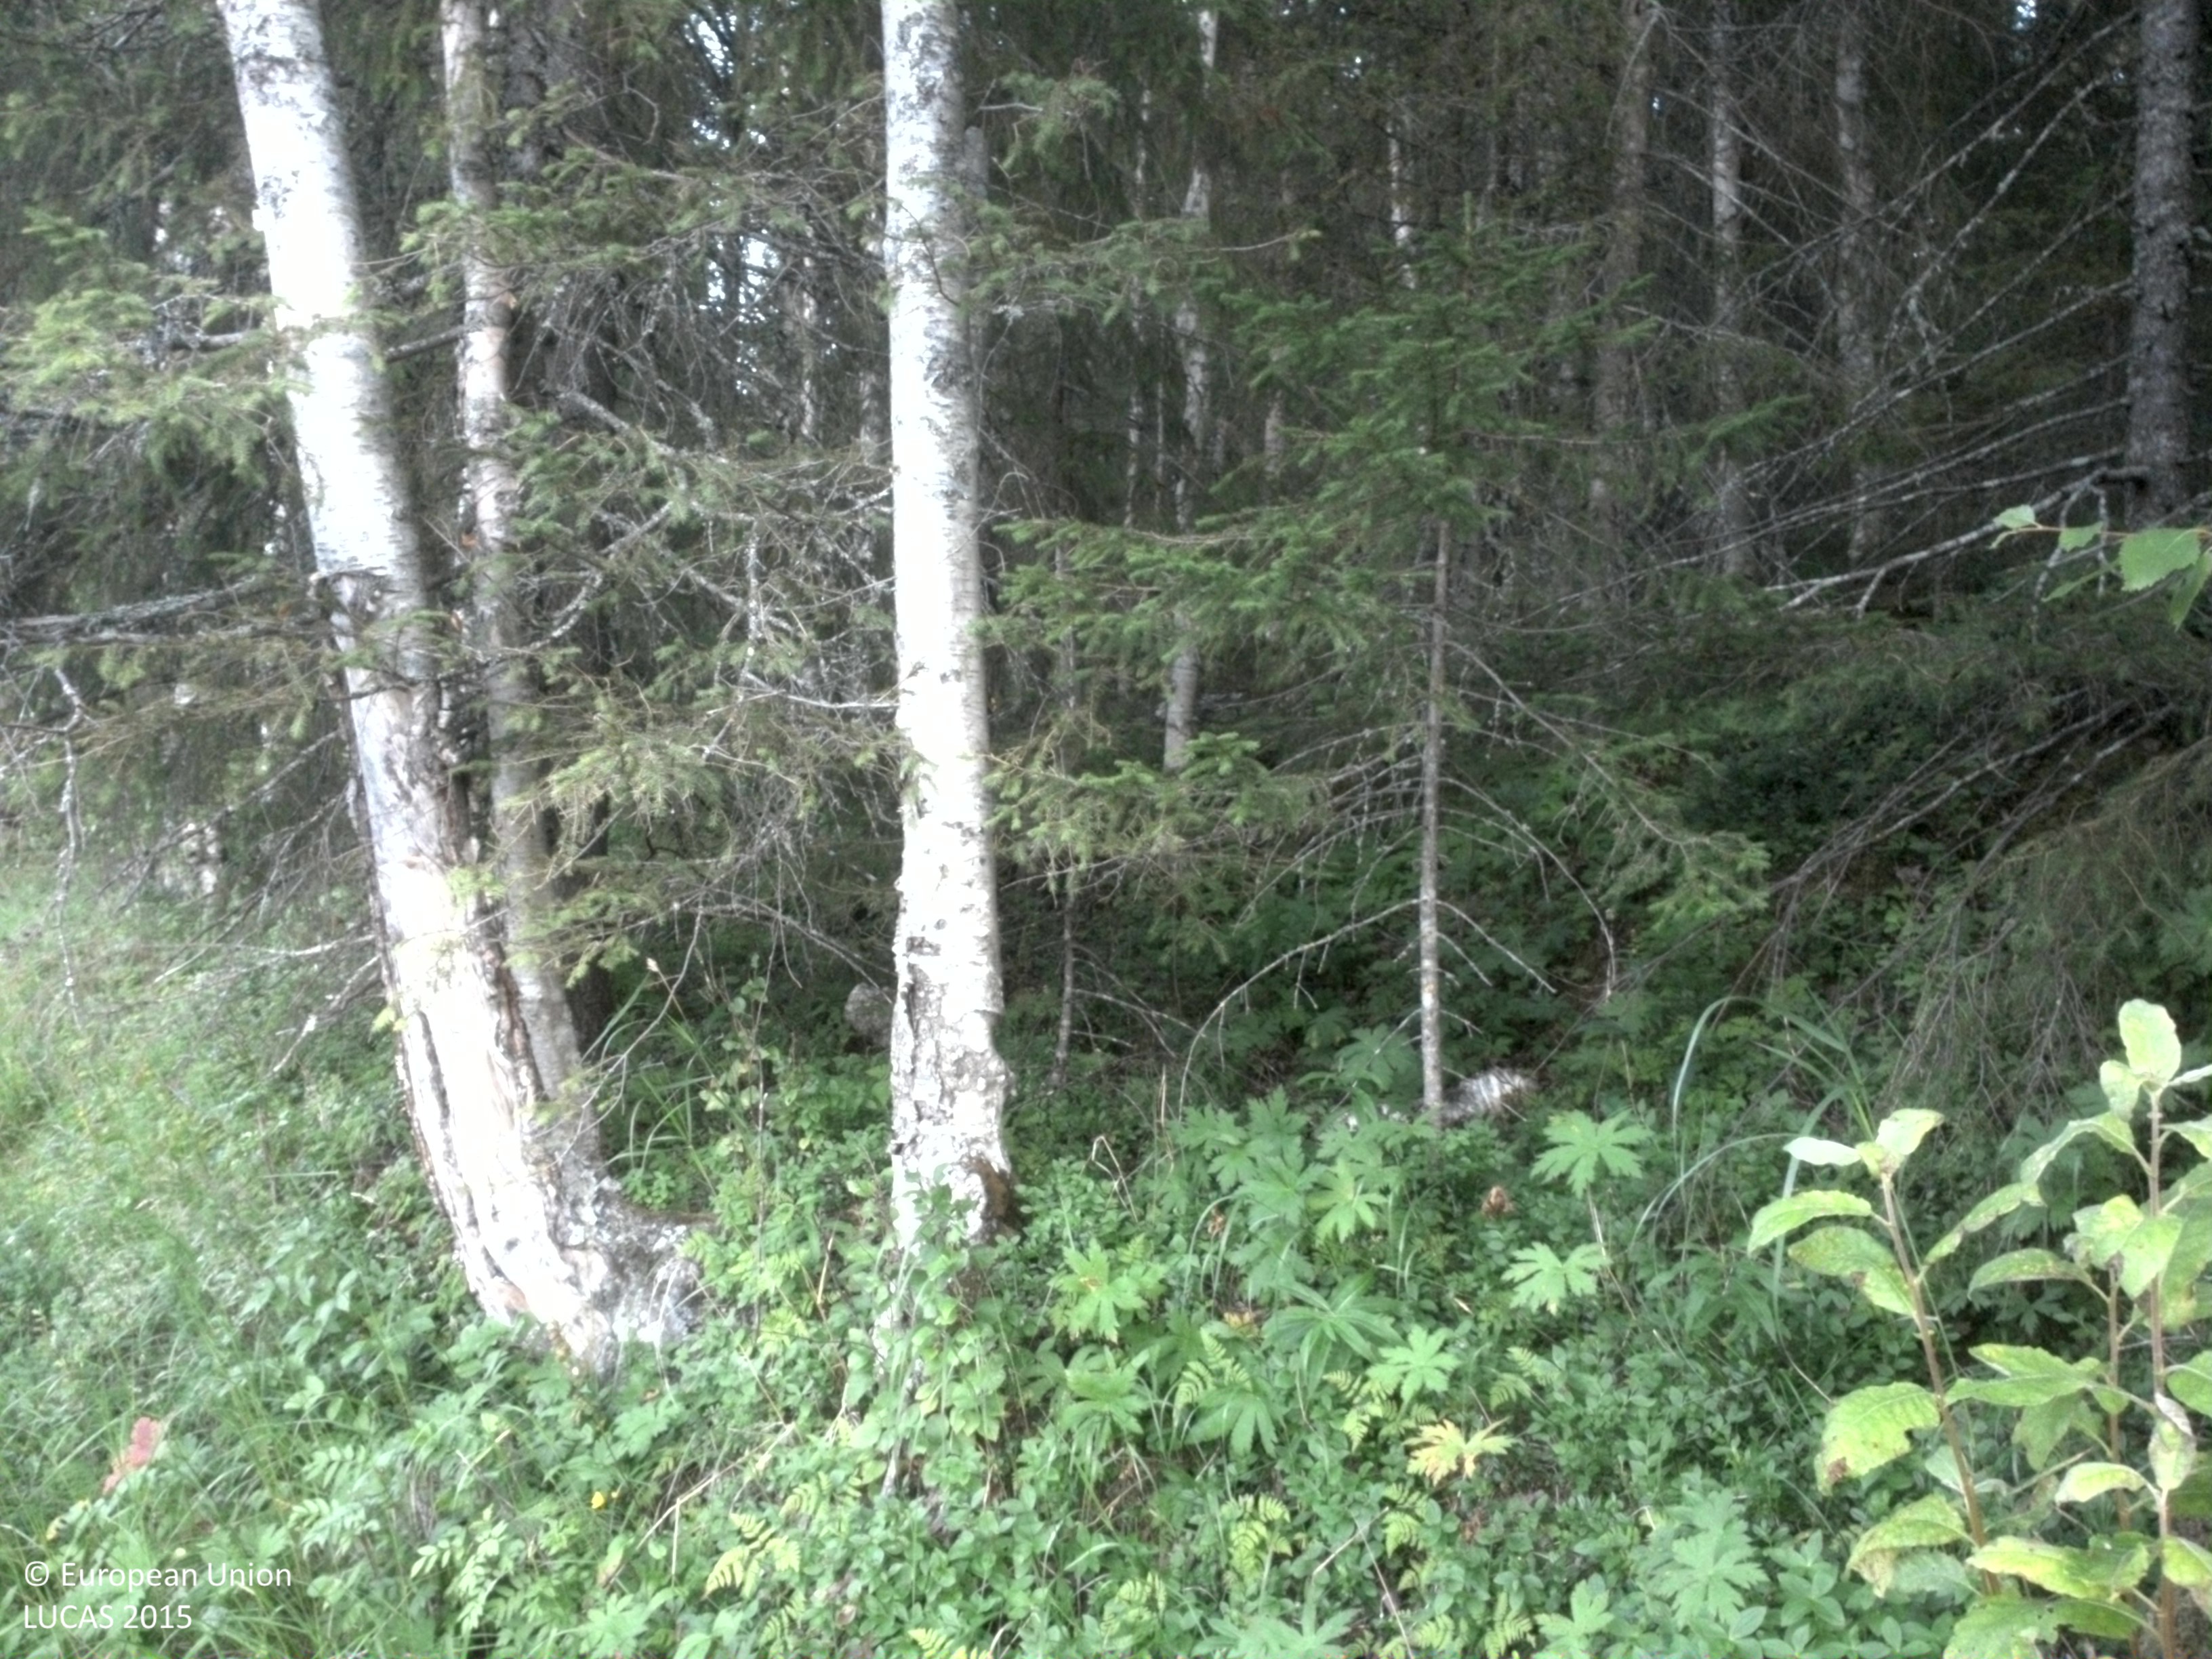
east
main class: Woodland
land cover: Spruce dominated mixed woodland
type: boreal forest
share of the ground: 50 - 75 %
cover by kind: coniferous forest trees 45 %, shrubs 30 %, broadleaved forest trees 15 %, herbaceous plants 10 %
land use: Forestry
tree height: > 5 m
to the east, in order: Spruce dominated mixed woodland; Inland fresh running water; Grassland with sparse tree/shrub cover; Spruce dominated mixed woodland; Paved roads, cycling and walking lanes; Shruby margins; Ditches and canals; Shrubland with sparse tree cover
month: August
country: SE
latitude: 64.4554
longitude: 18.2613
